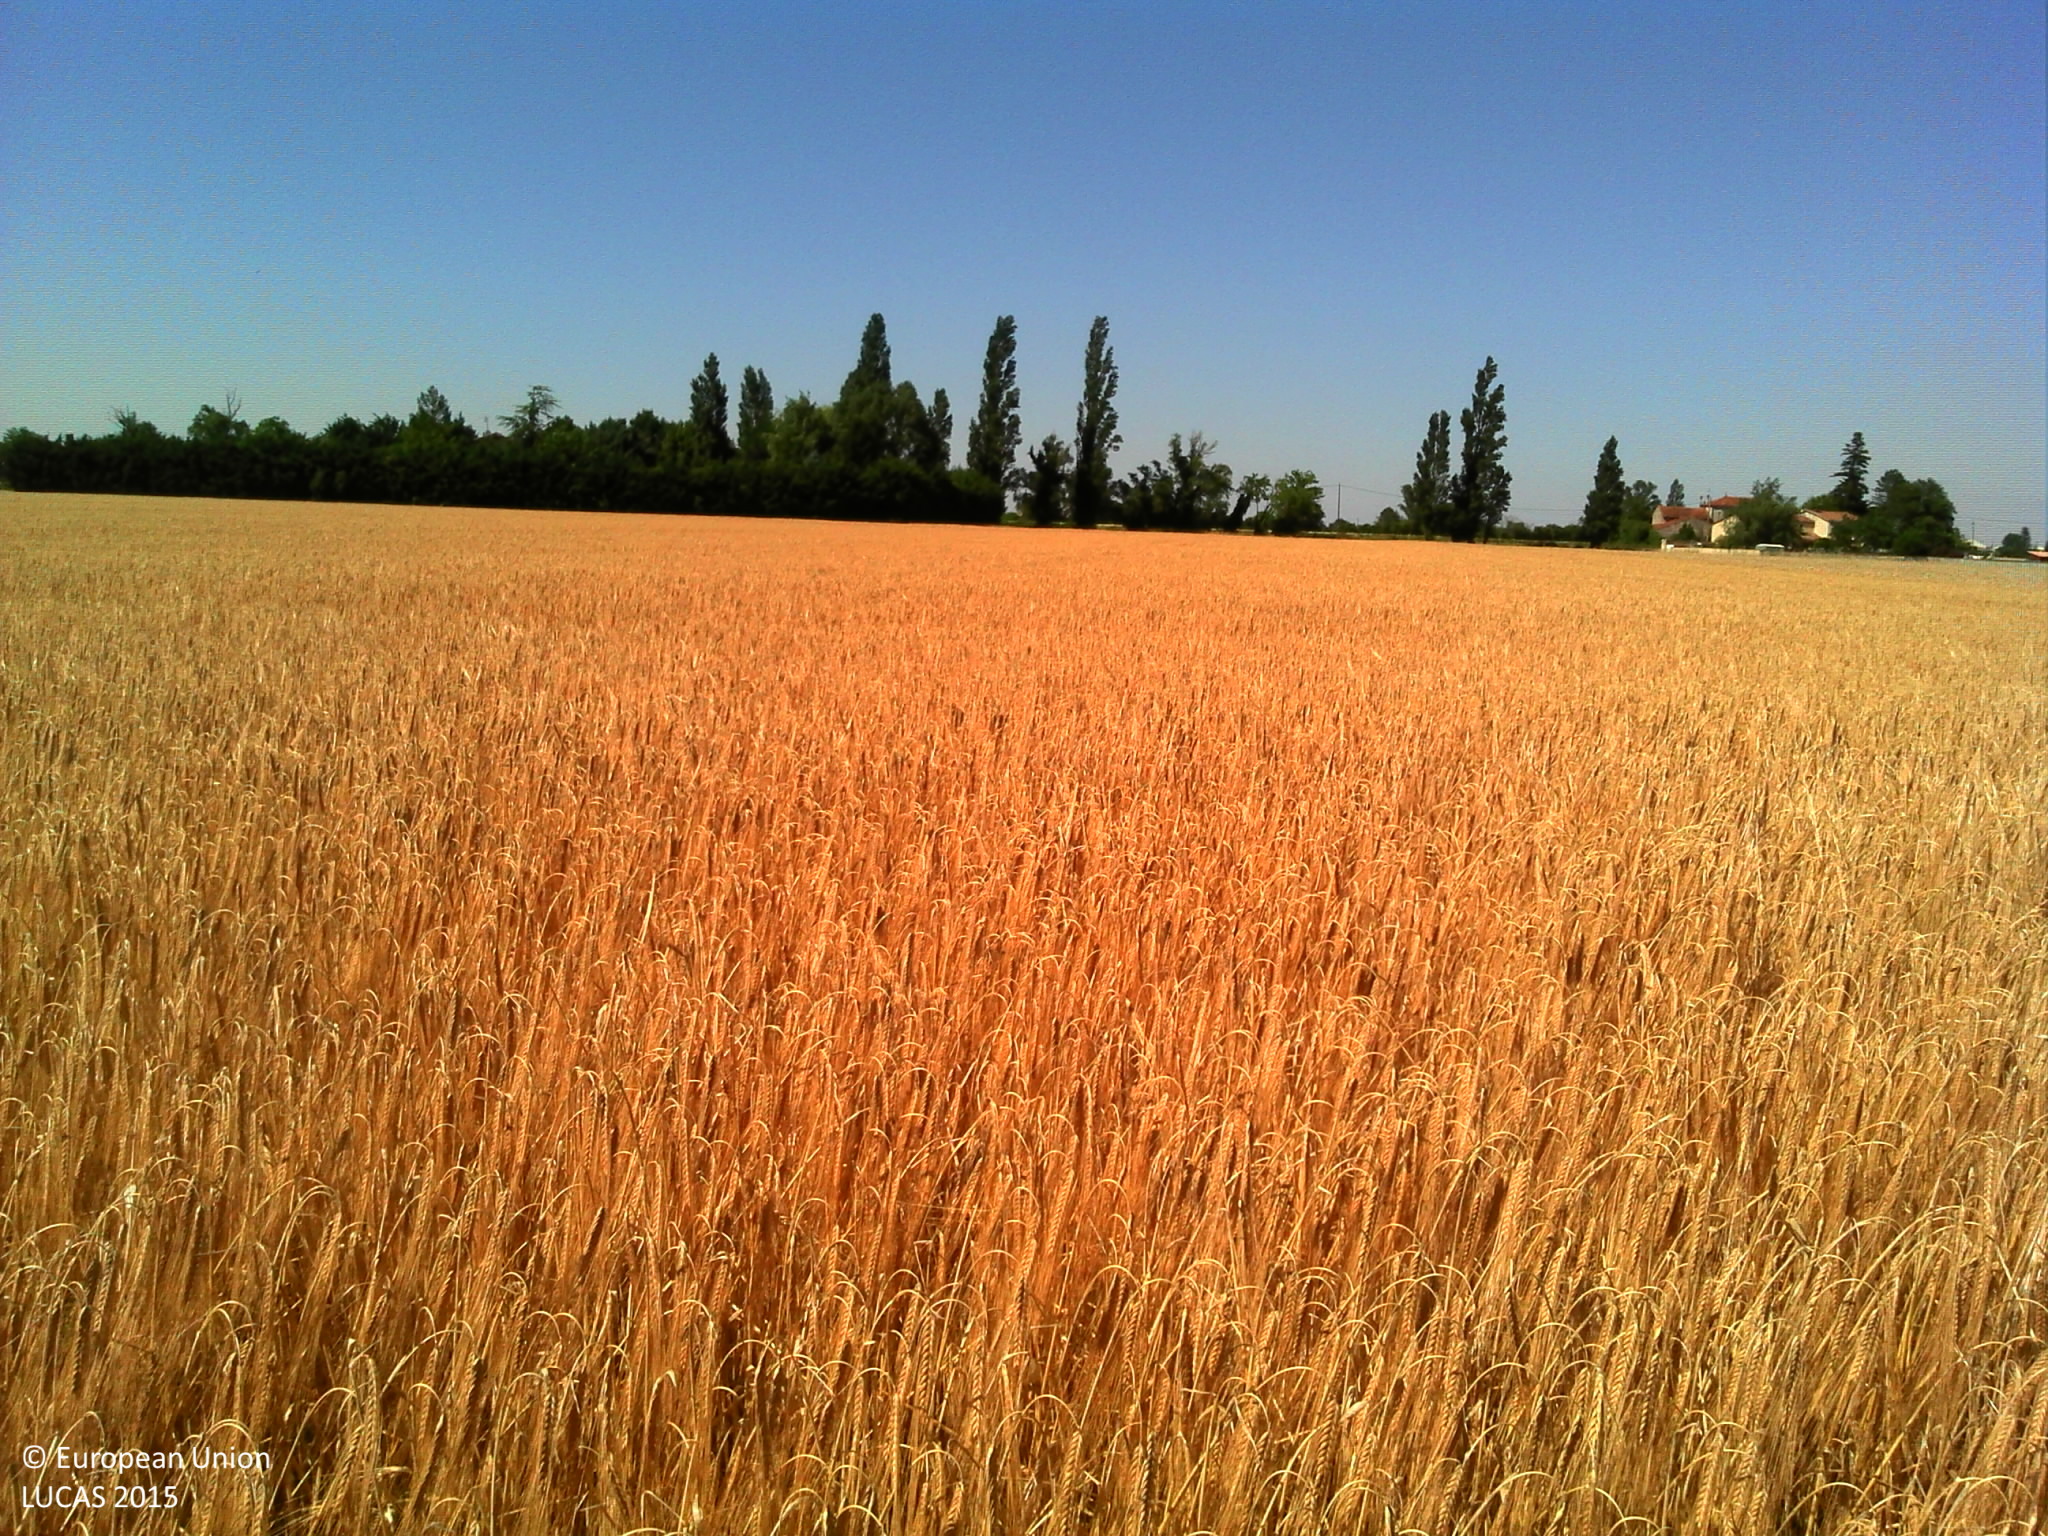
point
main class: Cropland
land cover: Barley
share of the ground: > 75 %
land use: Agriculture (excluding fallow land and kitchen gardens)
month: June
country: FR
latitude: 44.8974
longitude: 4.9785
